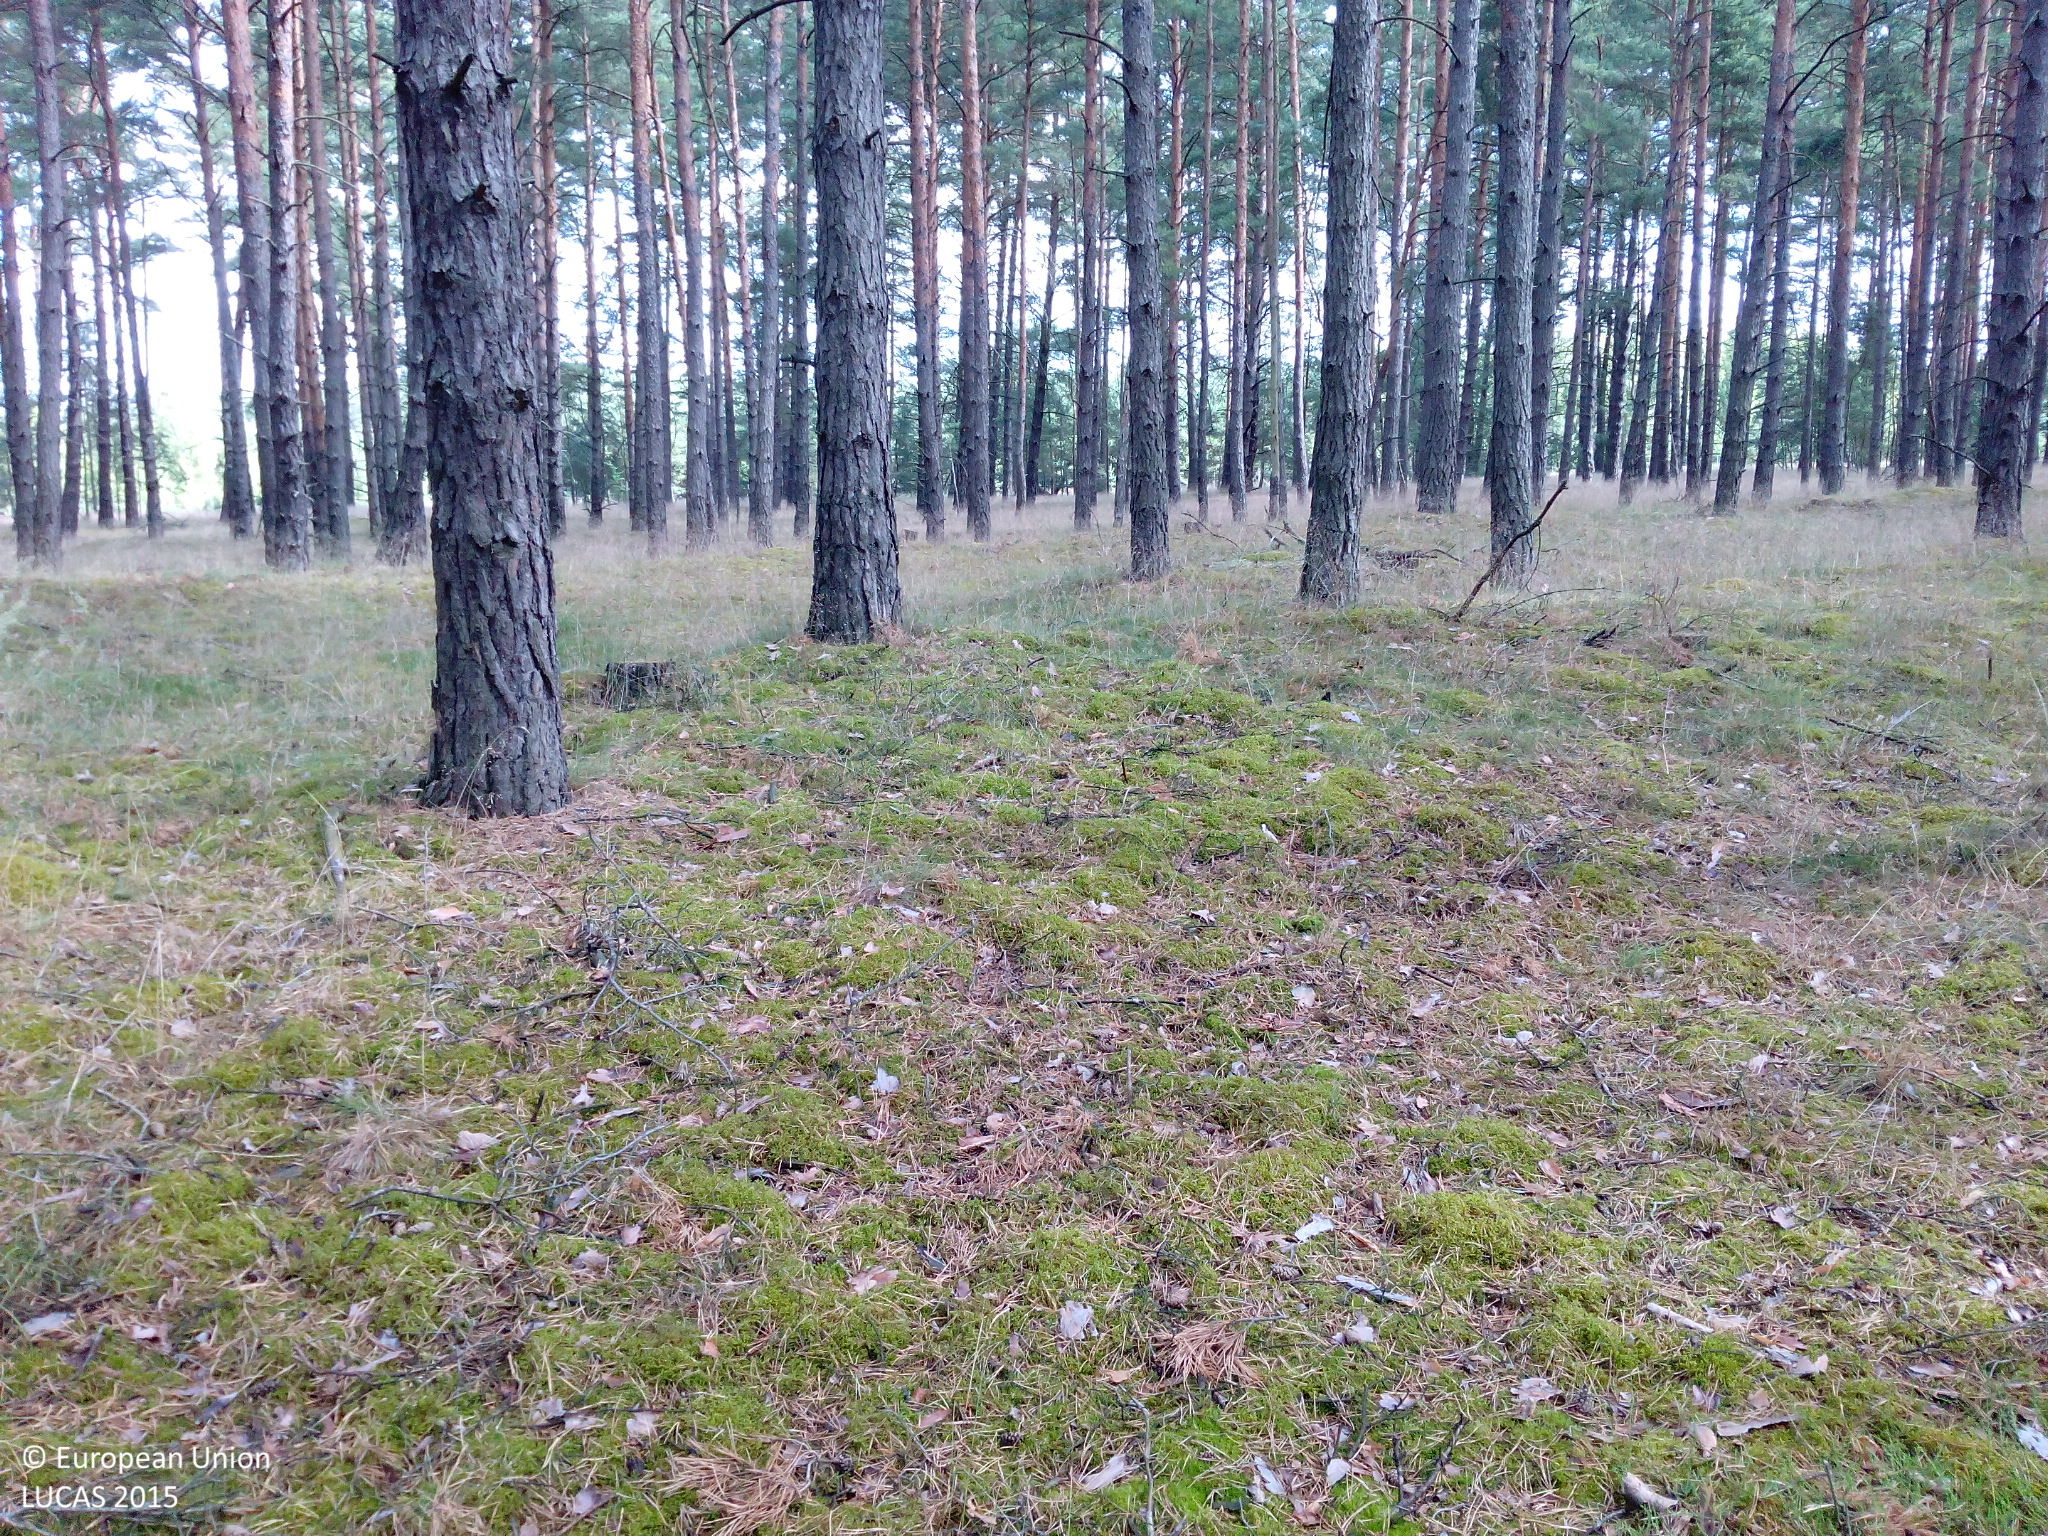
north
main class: Woodland
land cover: Pine dominated coniferous woodland
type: hemiboreal forest and nemoral coniferous forest and mixed broadleaved-coniferous forest
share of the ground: > 75 %
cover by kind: coniferous forest trees 80 %, herbaceous plants 10 %, lichens and mosses 10 %
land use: Forestry
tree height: > 5 m
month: July
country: DE
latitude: 52.8103
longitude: 13.5458
